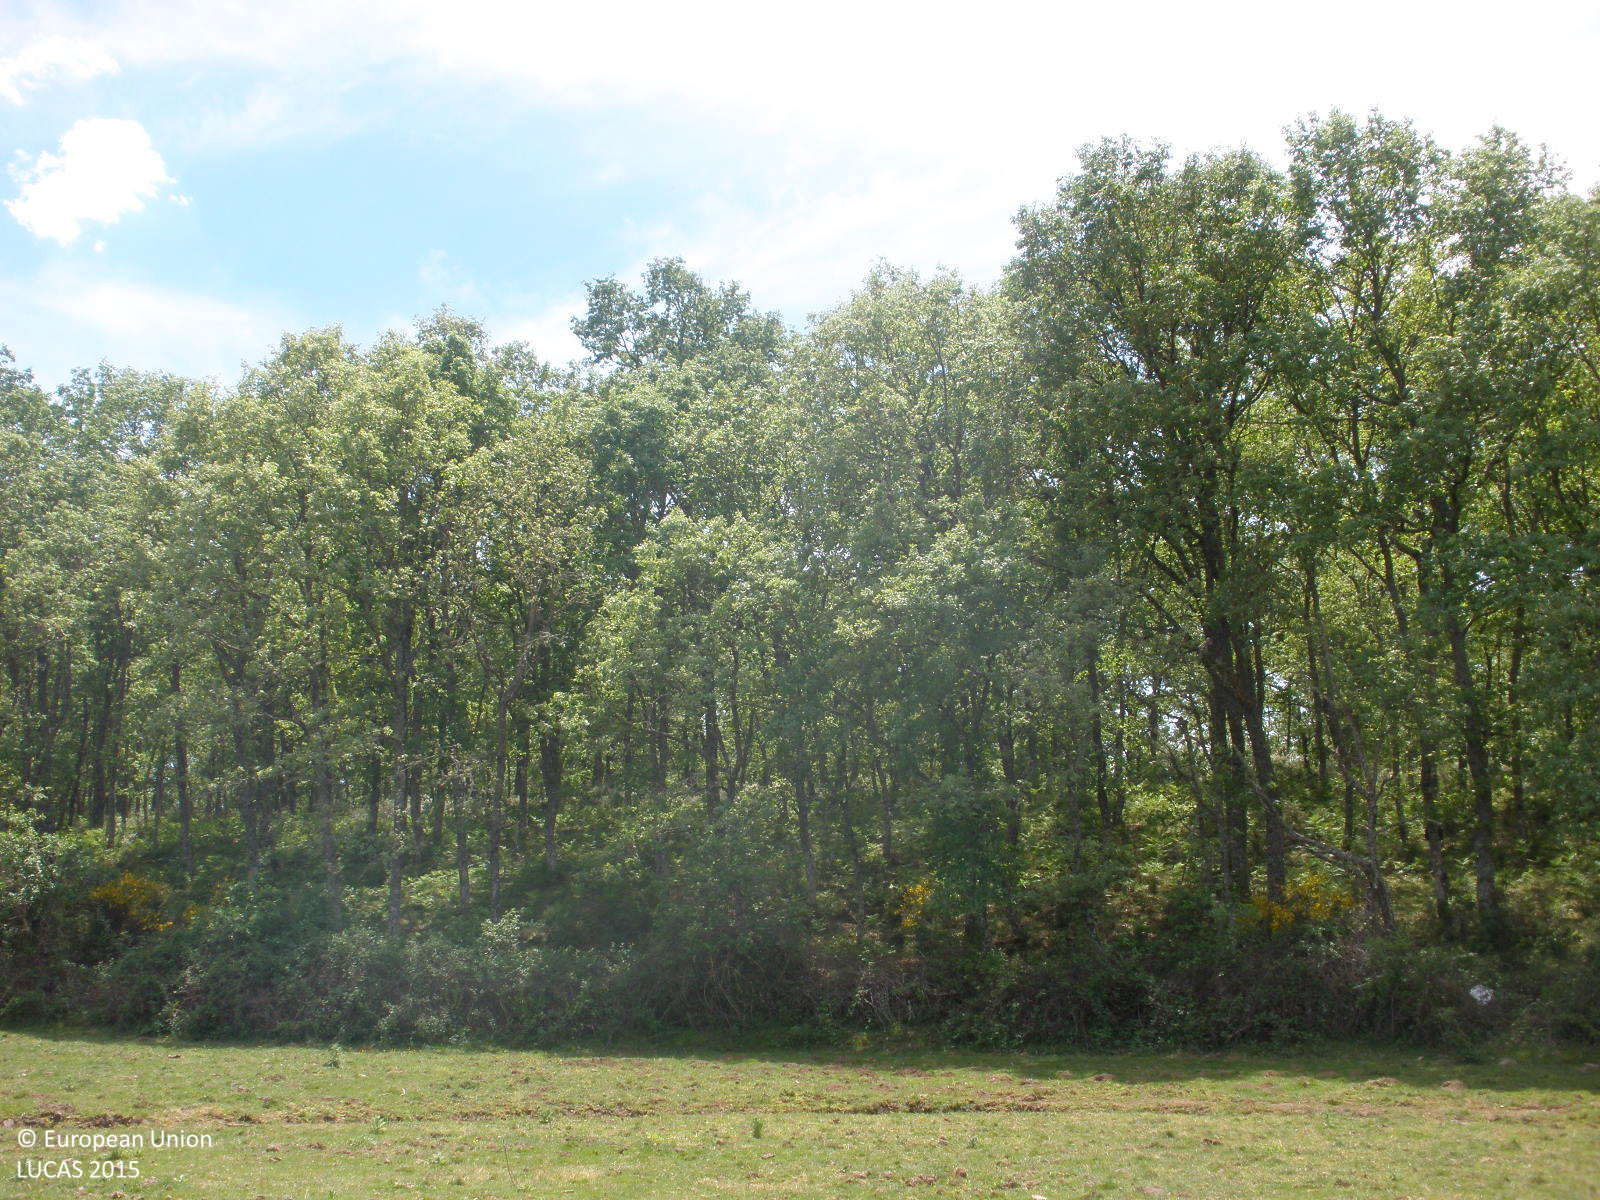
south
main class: Grassland
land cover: Grassland without tree/shrub cover
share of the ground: > 75 %
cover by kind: herbaceous plants 100 %
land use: Agriculture (excluding fallow land and kitchen gardens)
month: May
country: ES
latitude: 40.3300
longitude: -6.6245
